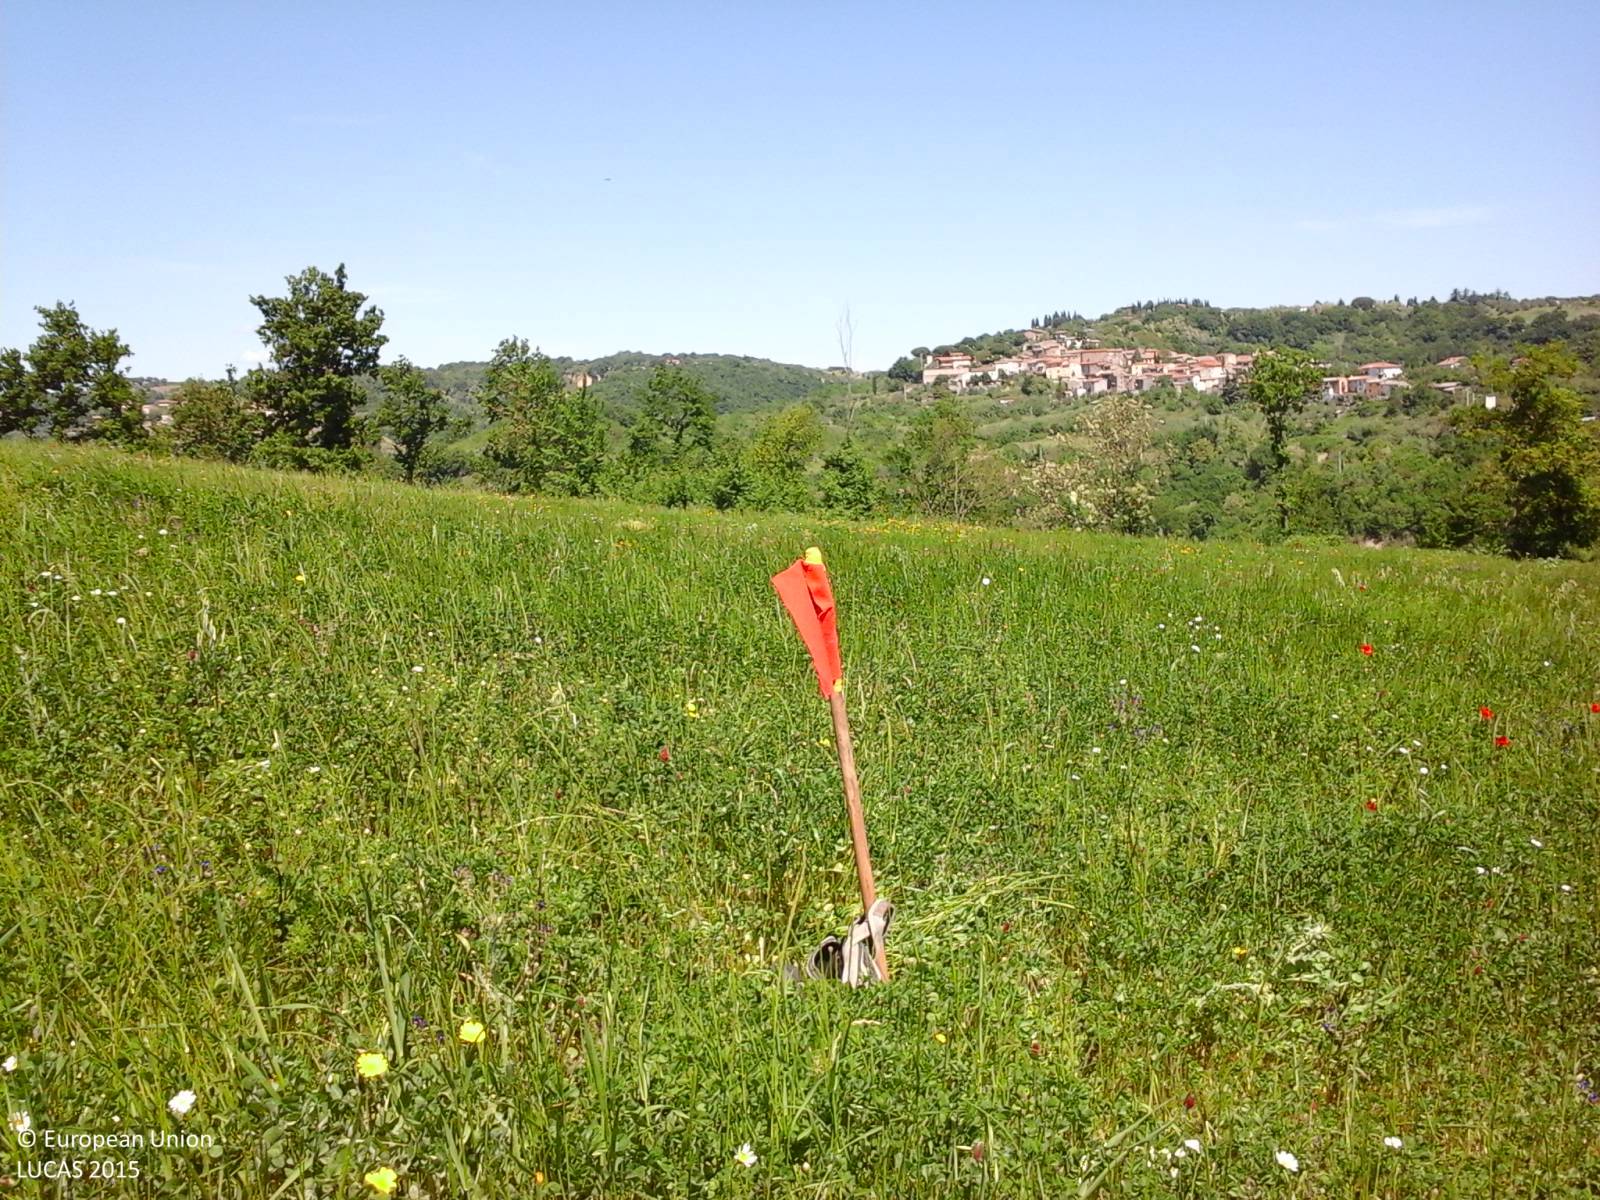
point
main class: Cropland
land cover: Lucerne
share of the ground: > 75 %
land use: Agriculture (excluding fallow land and kitchen gardens)
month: May
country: IT
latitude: 42.5585
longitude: 12.1730
